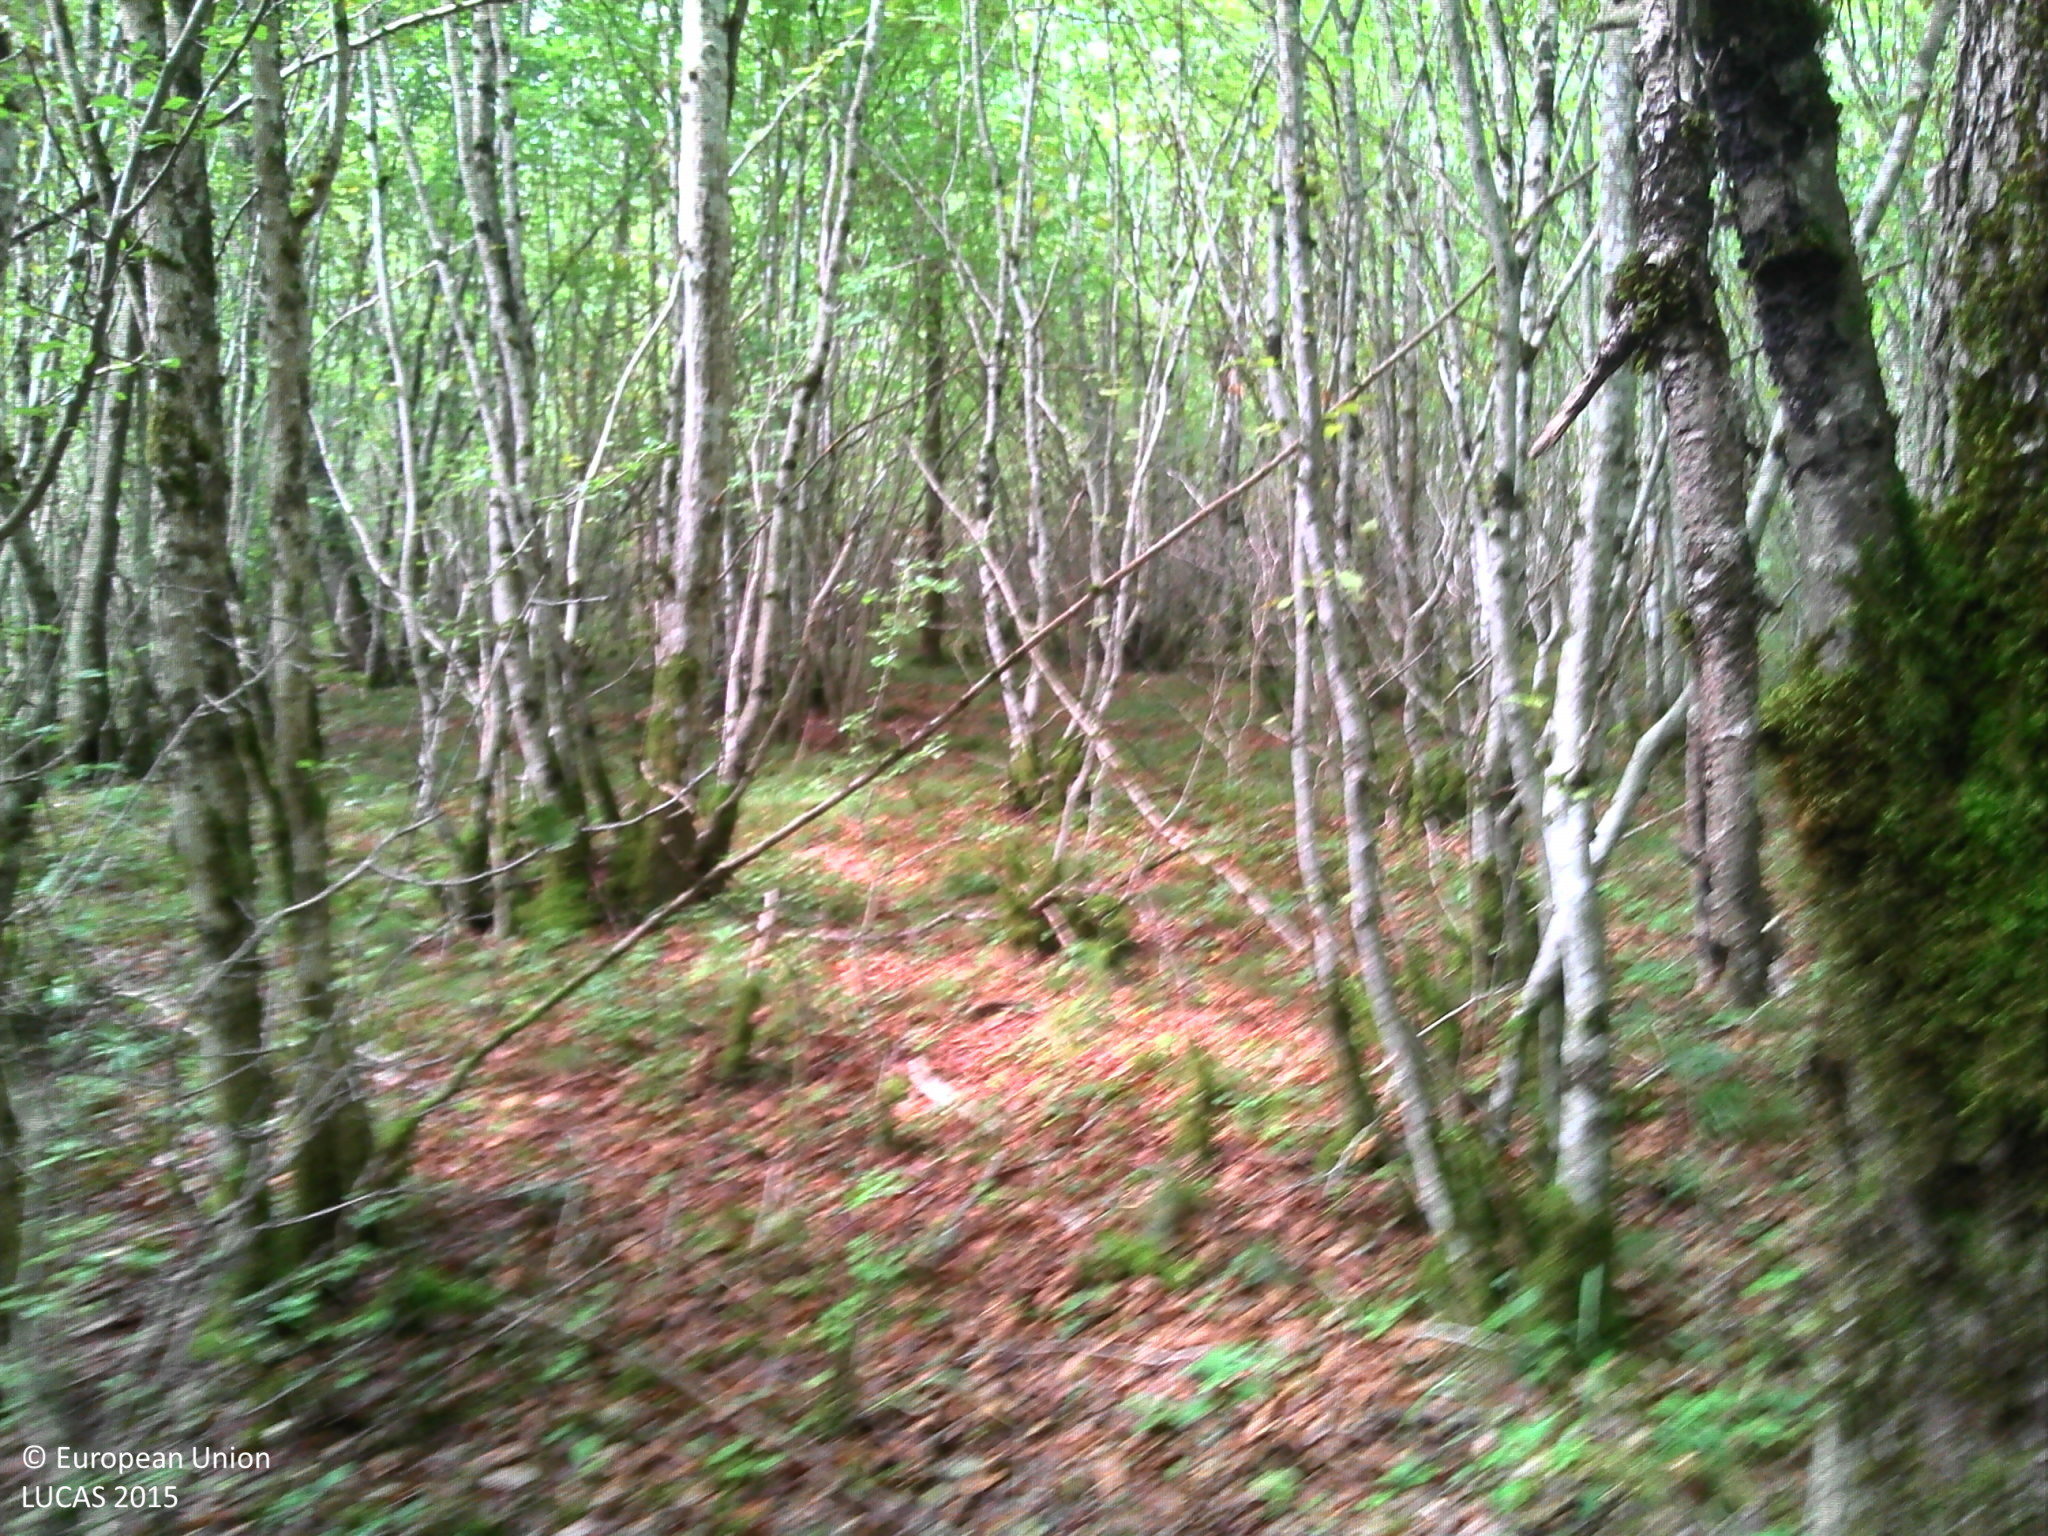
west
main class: Woodland
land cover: Broadleaved woodland
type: mesophytic deciduous forest
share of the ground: > 75 %
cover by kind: broadleaved forest trees 100 %
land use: Forestry
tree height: > 5 m
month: August
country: FR
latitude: 47.3625
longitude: 4.8229
